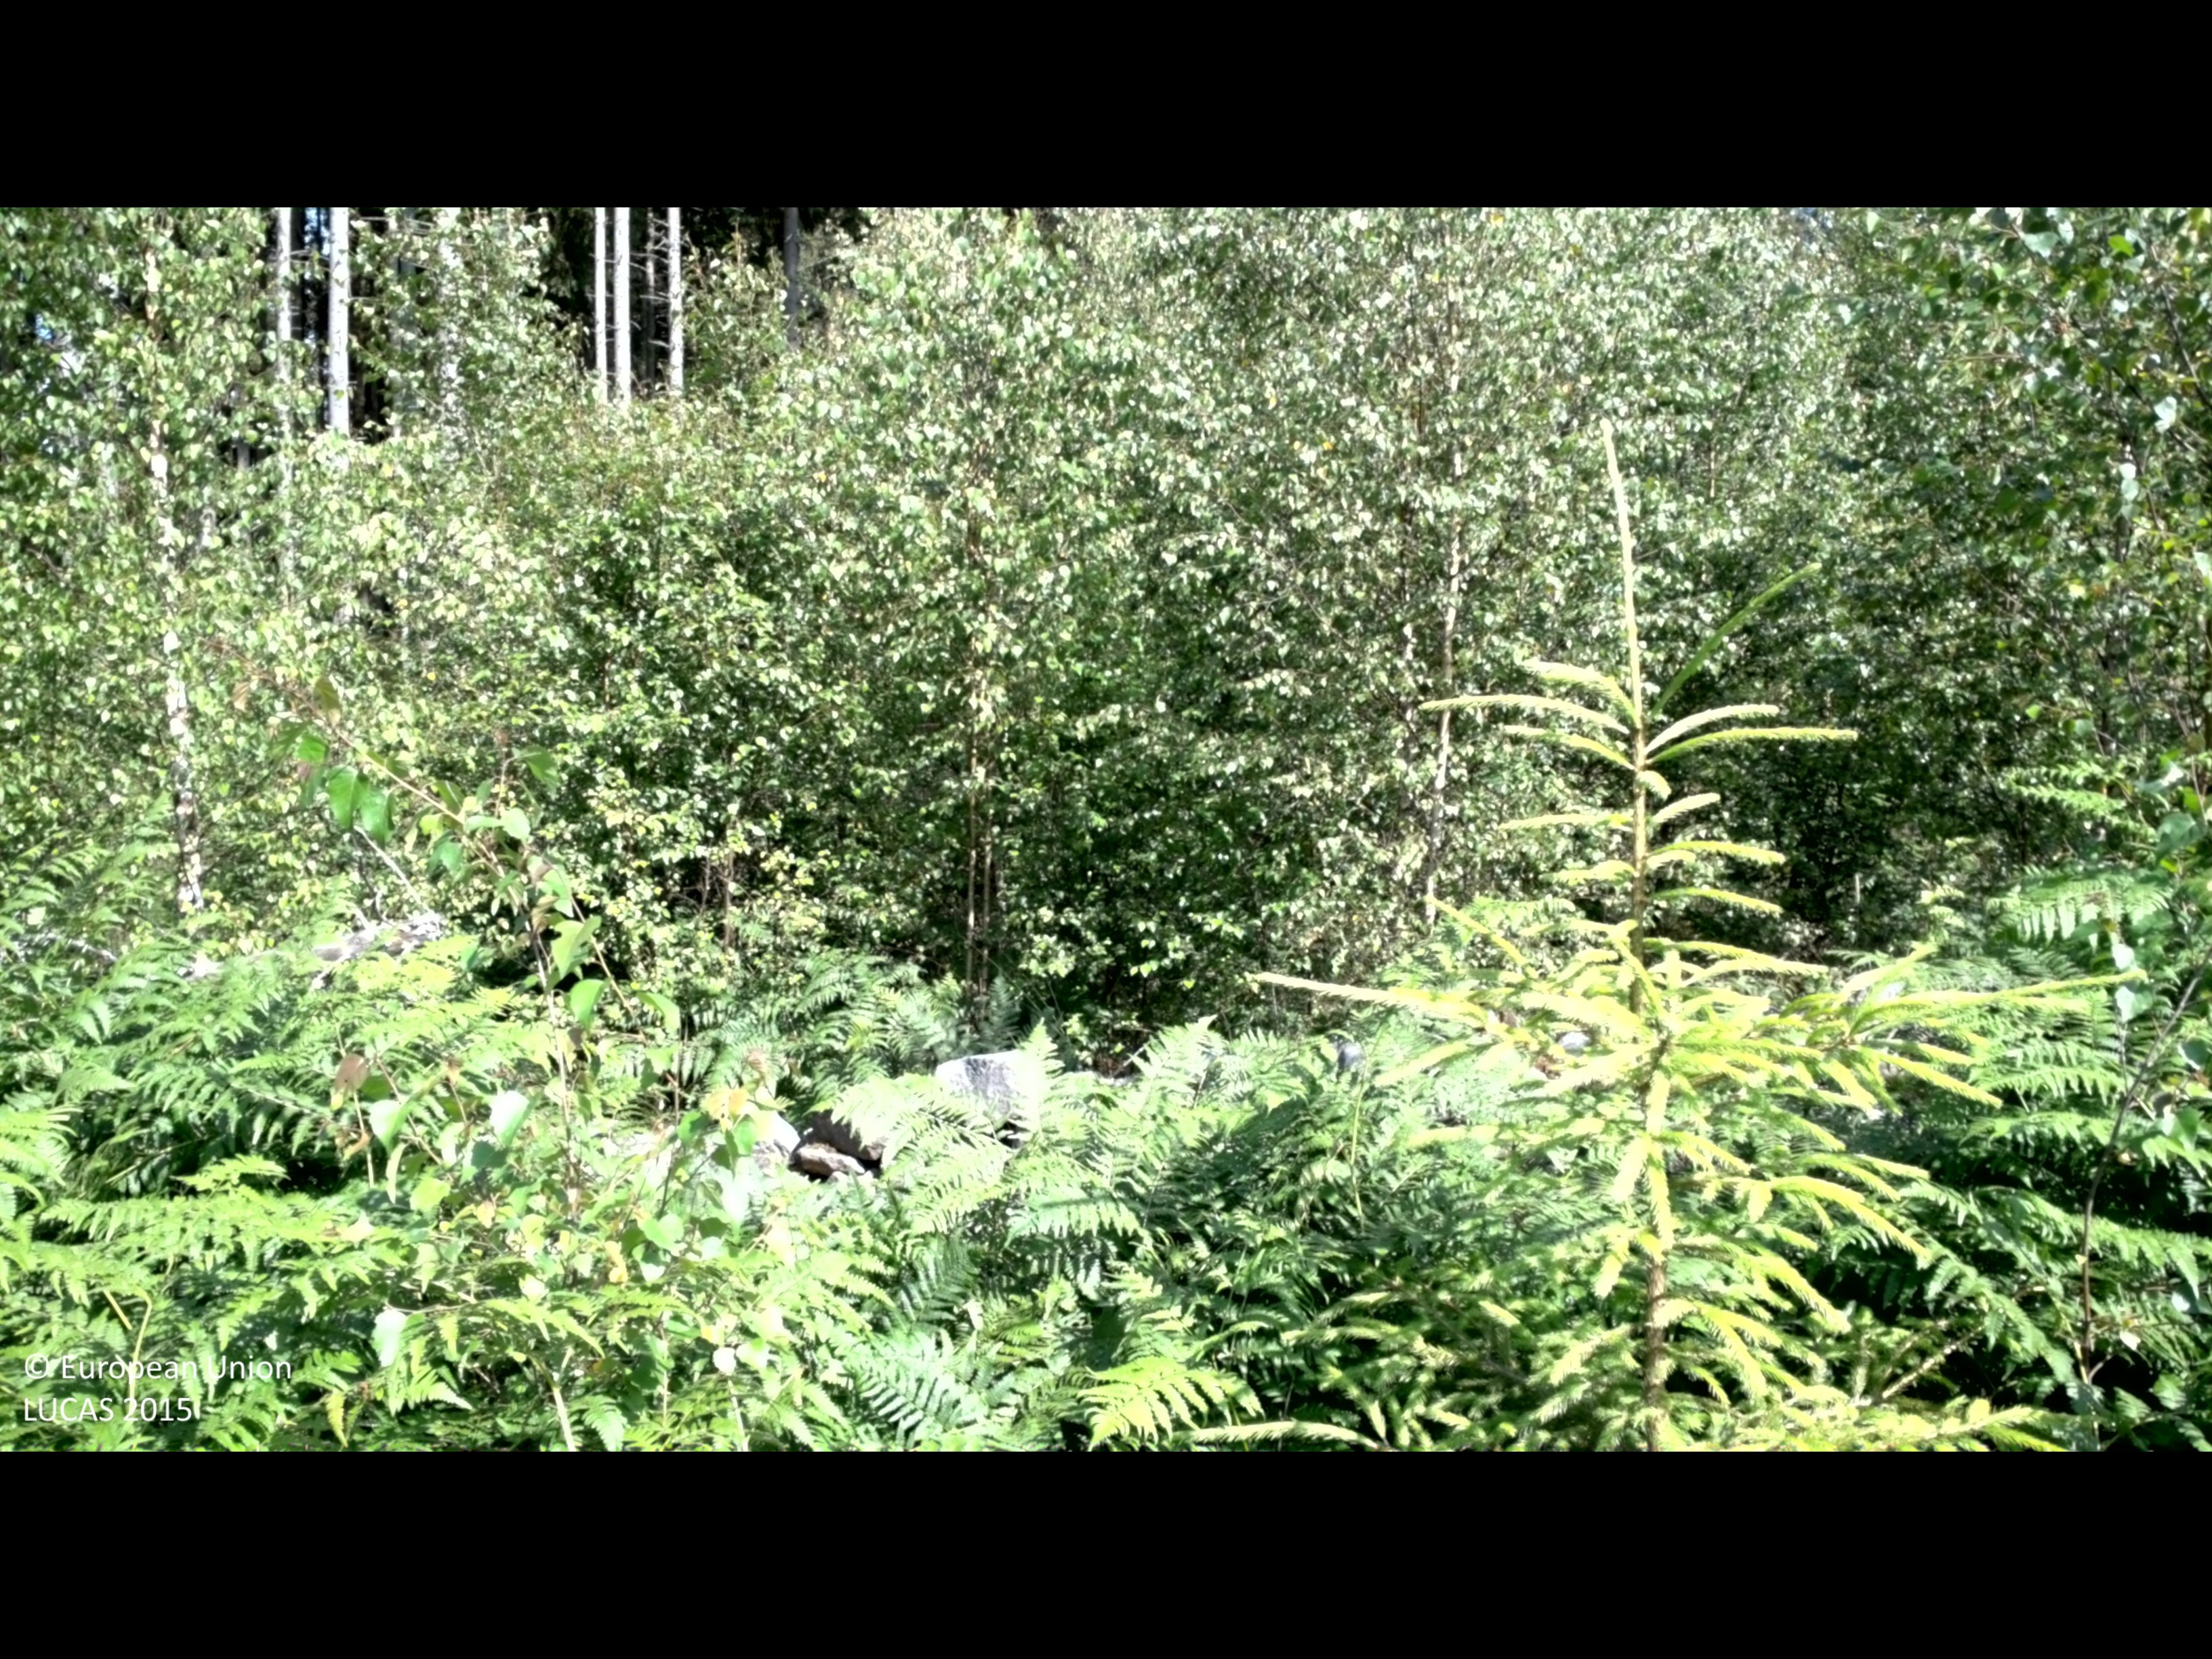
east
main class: Woodland
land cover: Broadleaved woodland
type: boreal forest
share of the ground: 50 - 75 %
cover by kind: broadleaved forest trees 55 %, herbaceous plants 20 %, coniferous forest trees 15 %, shrubs 10 %
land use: Forestry
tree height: < 5 m
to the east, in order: Broadleaved woodland; Dry stone walls; Broadleaved woodland; Spruce dominated coniferous woodland; Dry stone walls; Tracks; Spruce dominated coniferous woodland
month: July
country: SE
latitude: 56.4949
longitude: 14.2692
